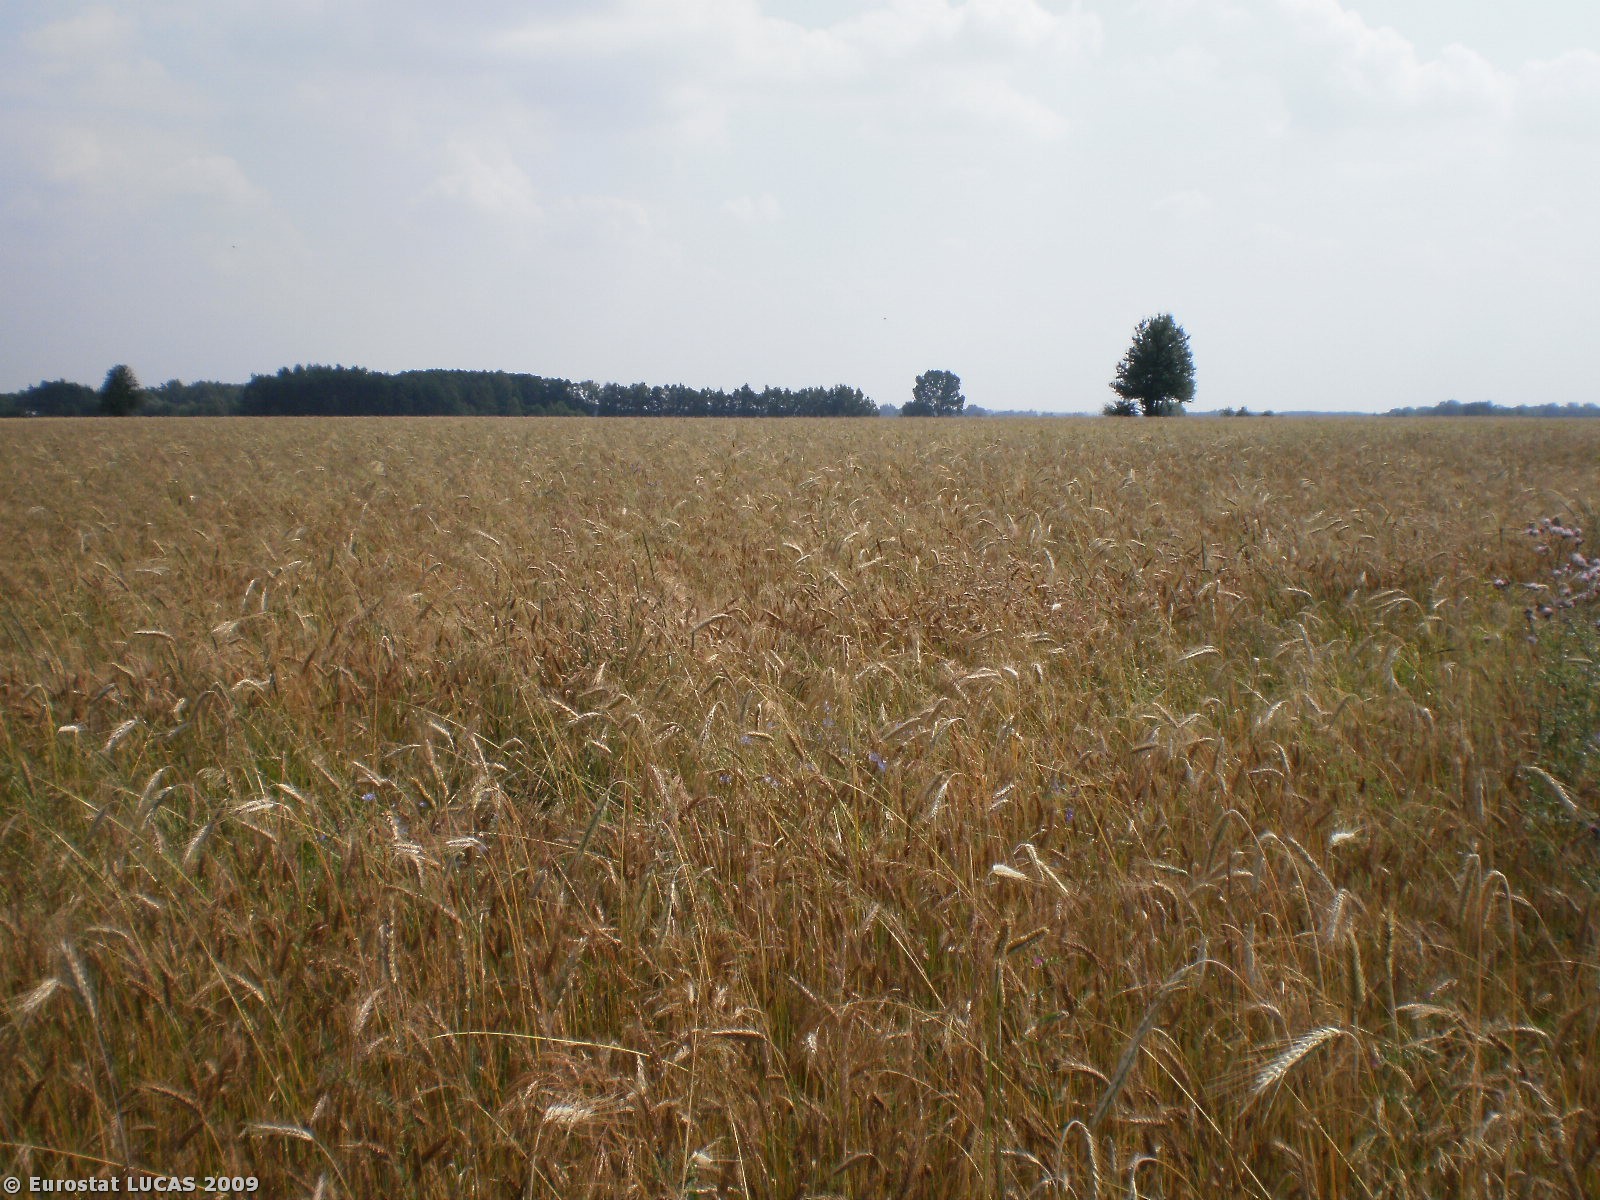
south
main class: Cropland
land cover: Triticale
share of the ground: > 75 %
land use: Agriculture (excluding fallow land and kitchen gardens)
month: July
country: PL
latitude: 52.6438
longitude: 20.8158
